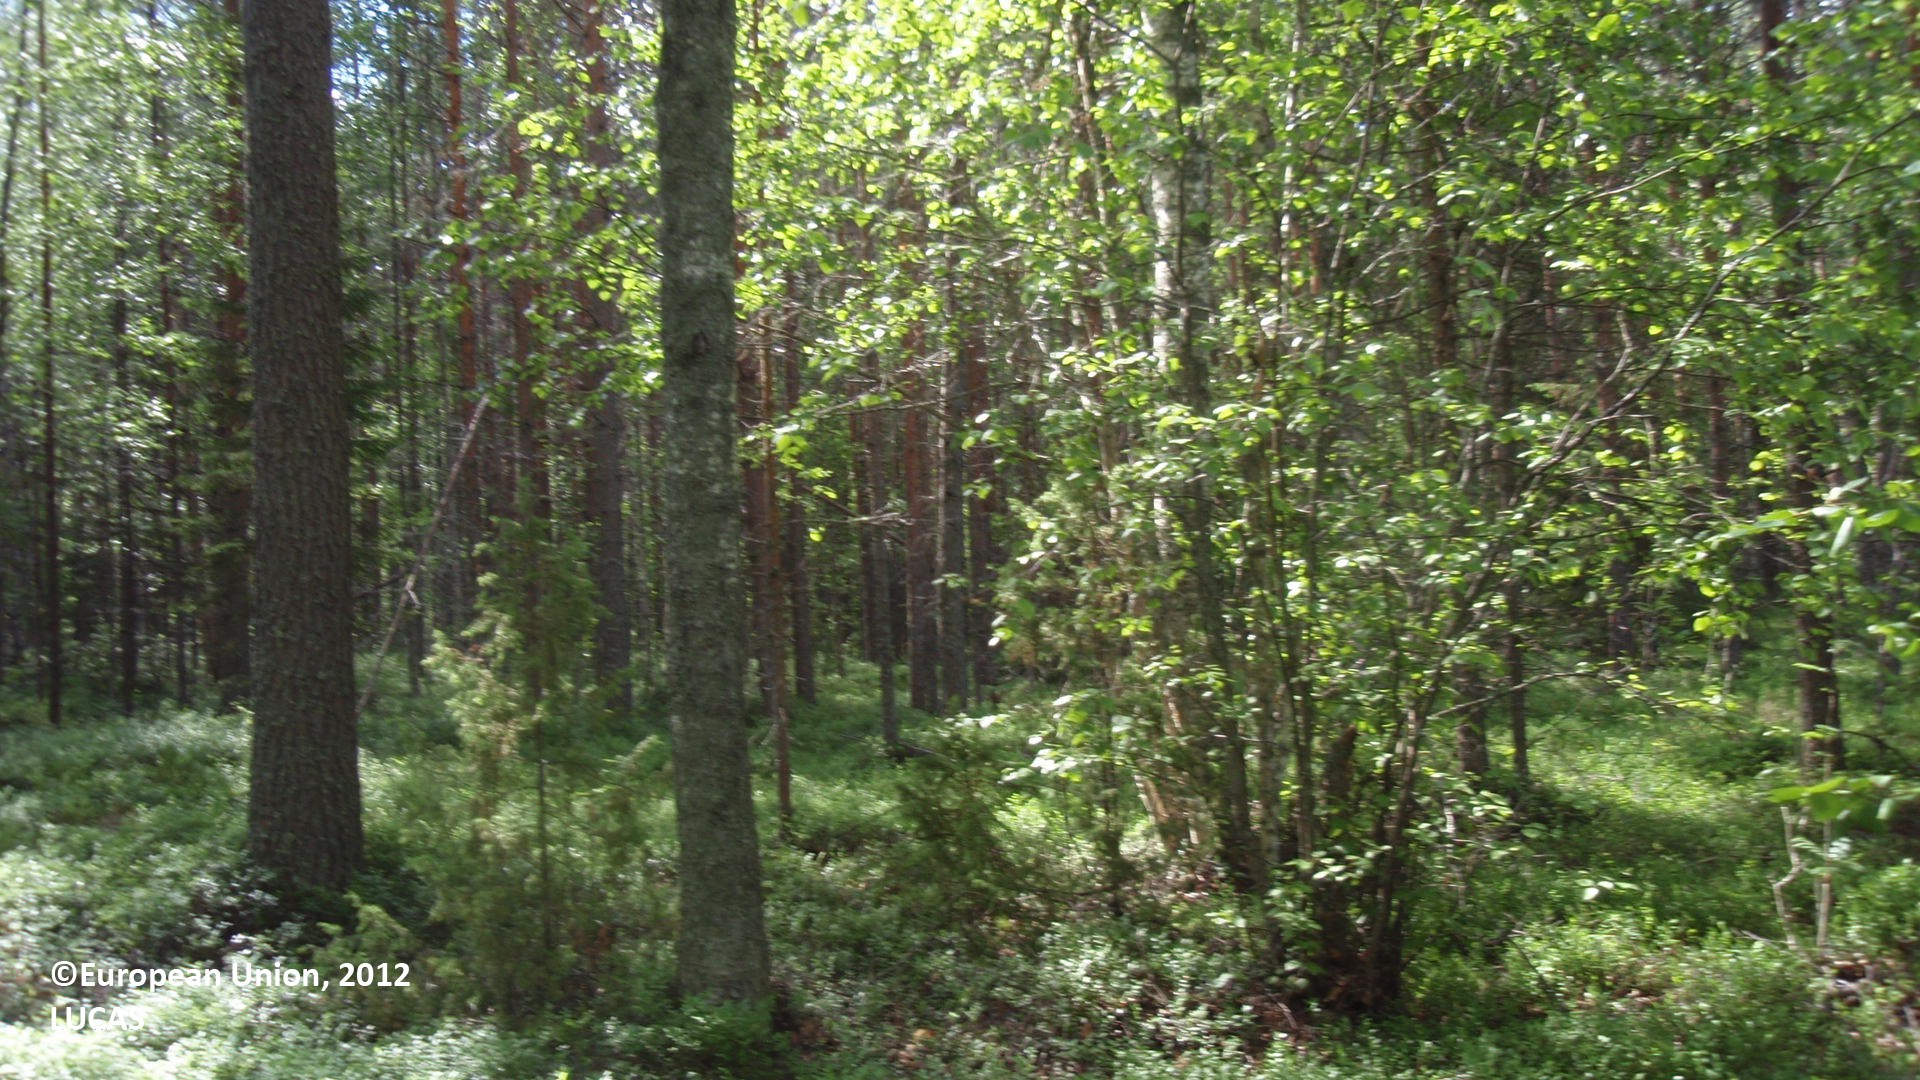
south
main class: Woodland
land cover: Pine dominated mixed woodland
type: boreal forest
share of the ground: 25 - 50 %
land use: Forestry
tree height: > 5 m
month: July
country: FI
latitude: 61.6728
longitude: 28.2032
